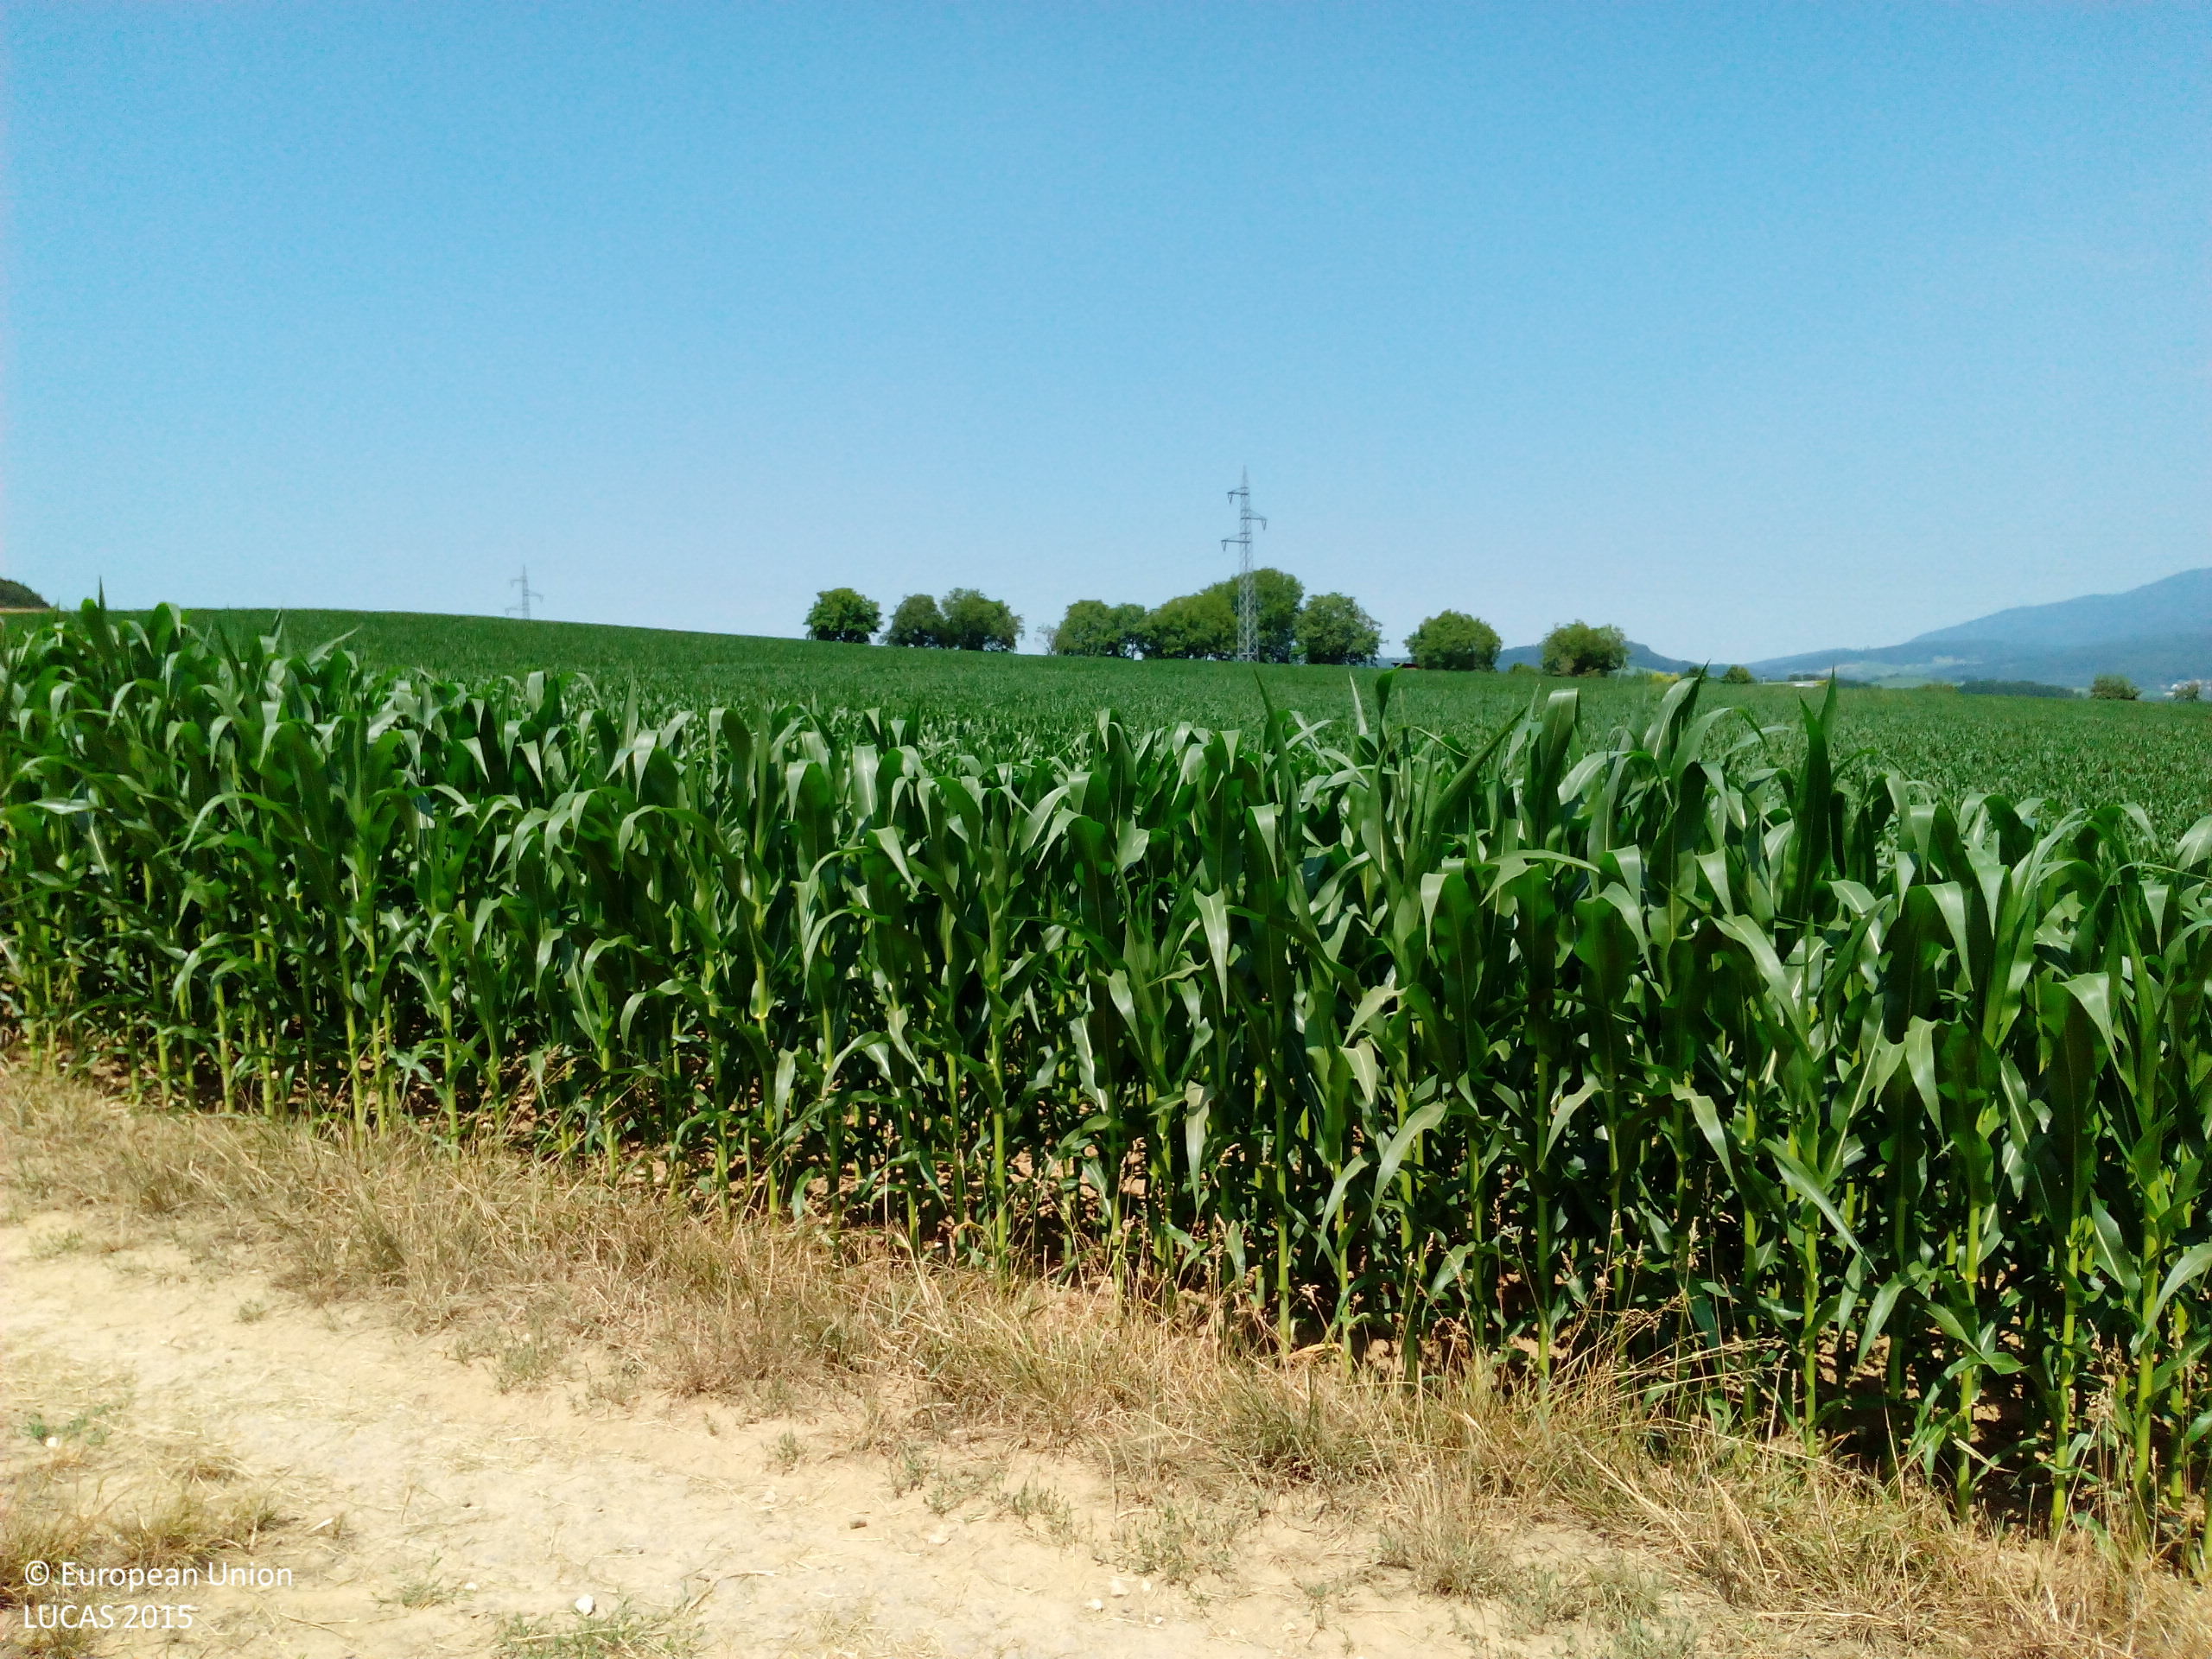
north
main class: Cropland
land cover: Maize
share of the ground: > 75 %
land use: Agriculture (excluding fallow land and kitchen gardens)
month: July
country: DE
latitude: 47.6751
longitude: 7.5907
